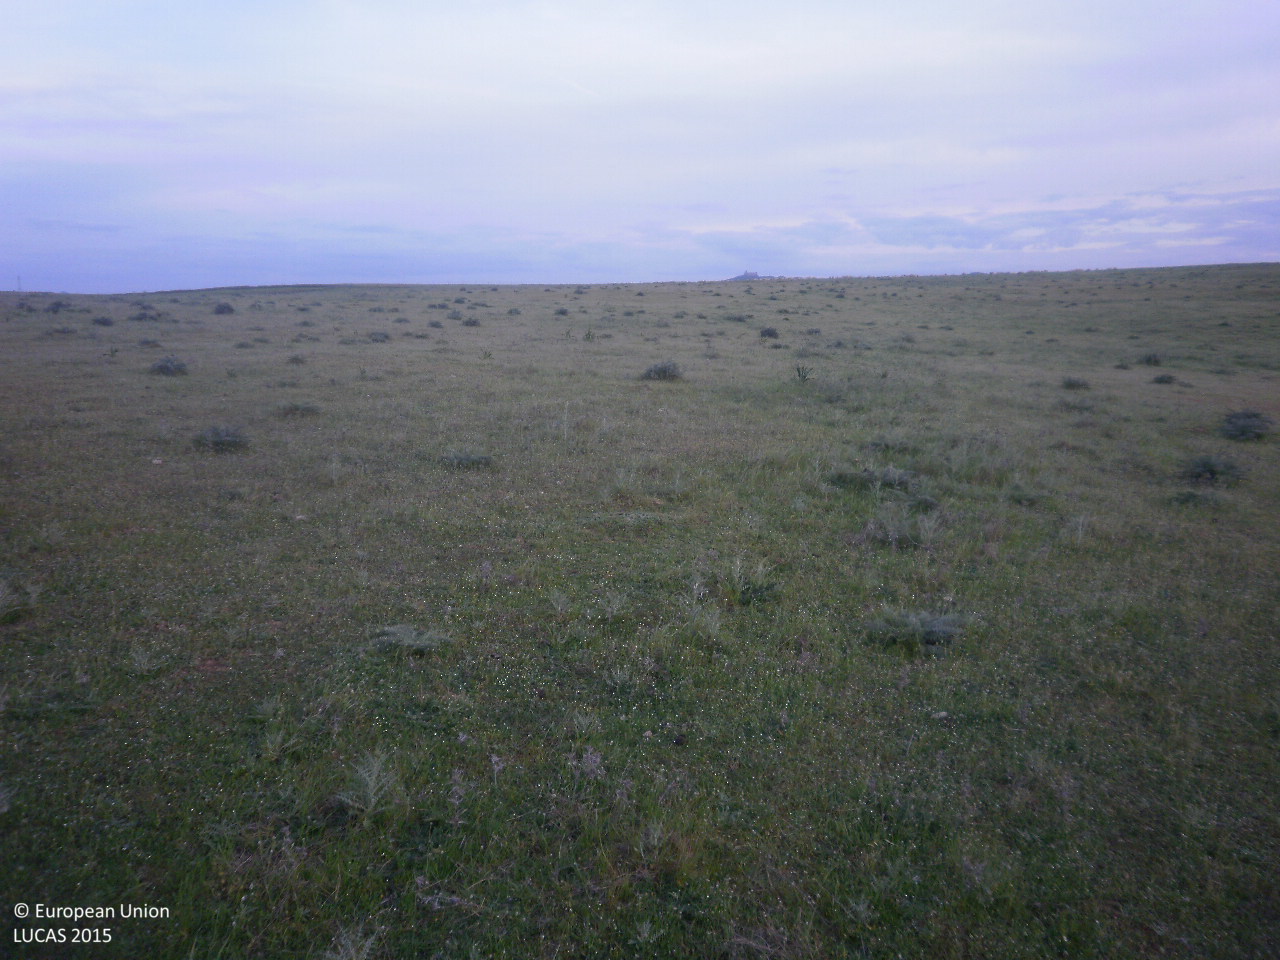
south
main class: Grassland
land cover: Grassland without tree/shrub cover
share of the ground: > 75 %
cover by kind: herbaceous plants 100 %
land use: Agriculture (excluding fallow land and kitchen gardens)
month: April
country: ES
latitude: 39.0477
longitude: -5.2577
